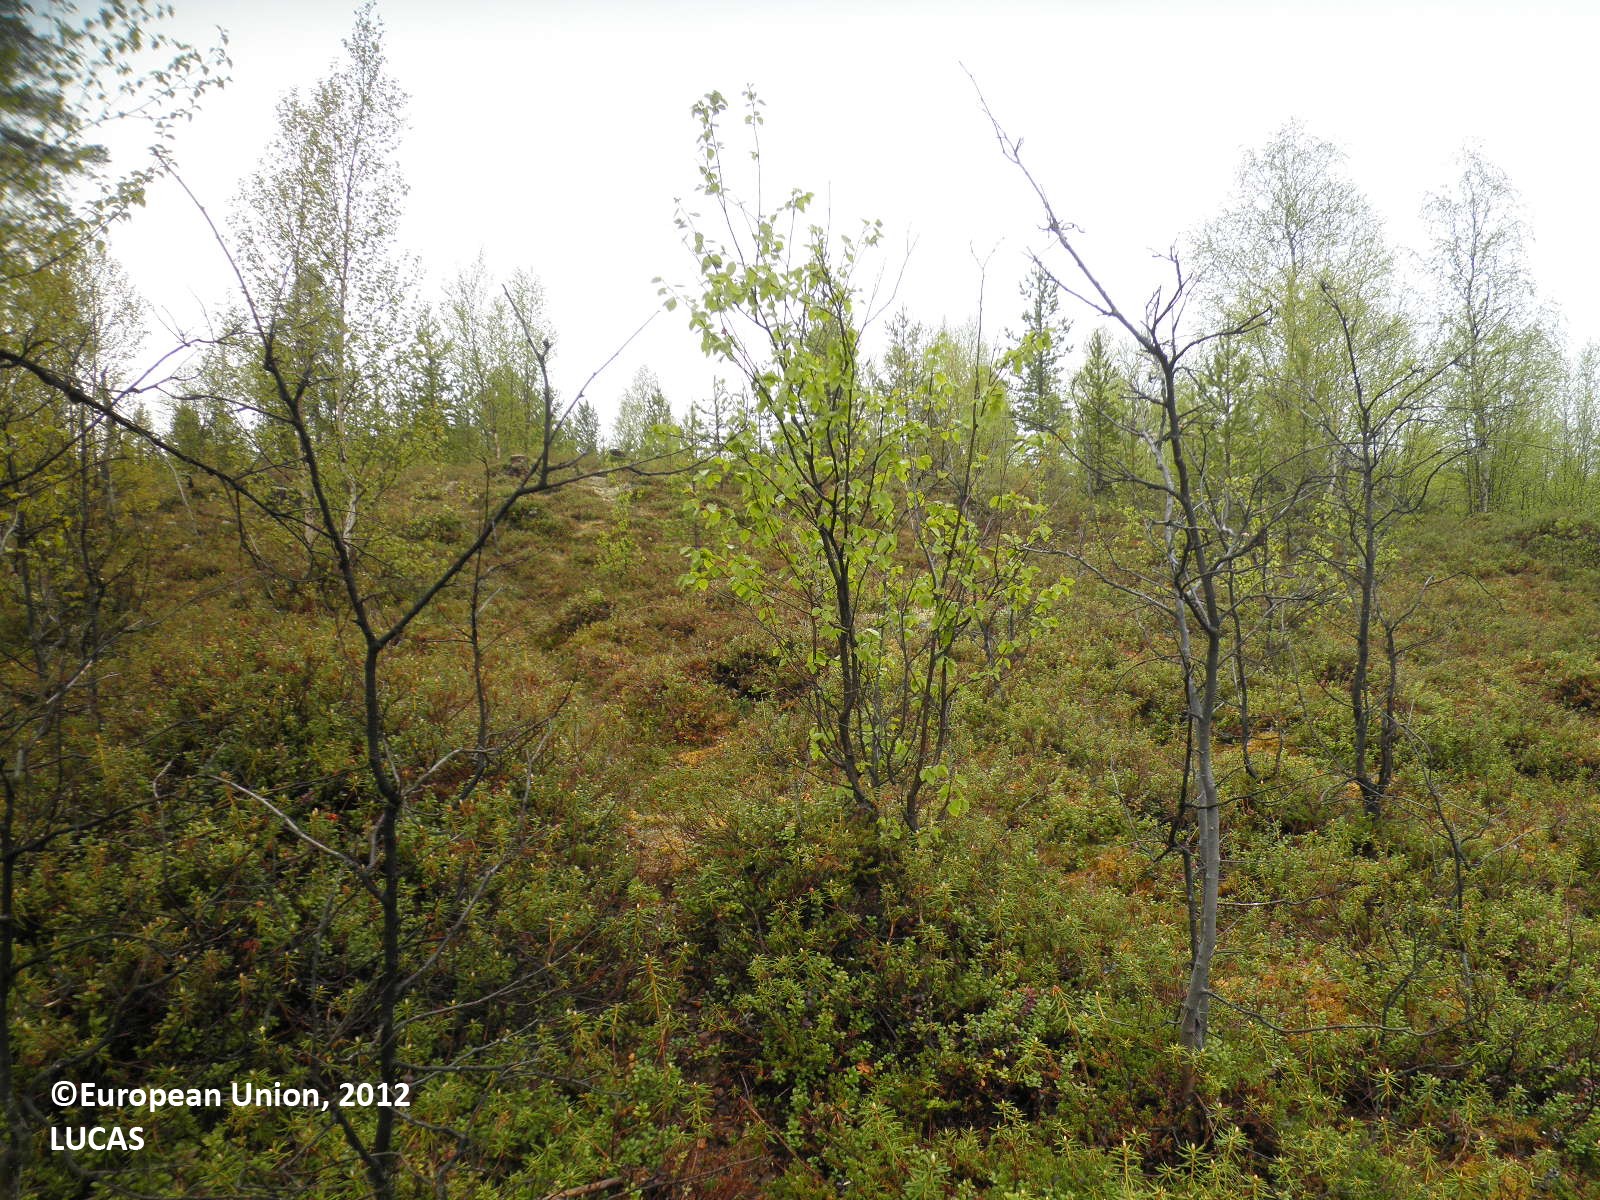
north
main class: Woodland
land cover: Pine dominated mixed woodland
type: boreal forest
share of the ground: 50 - 75 %
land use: Forestry
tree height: > 5 m
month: June
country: FI
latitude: 68.7940
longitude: 27.8459
